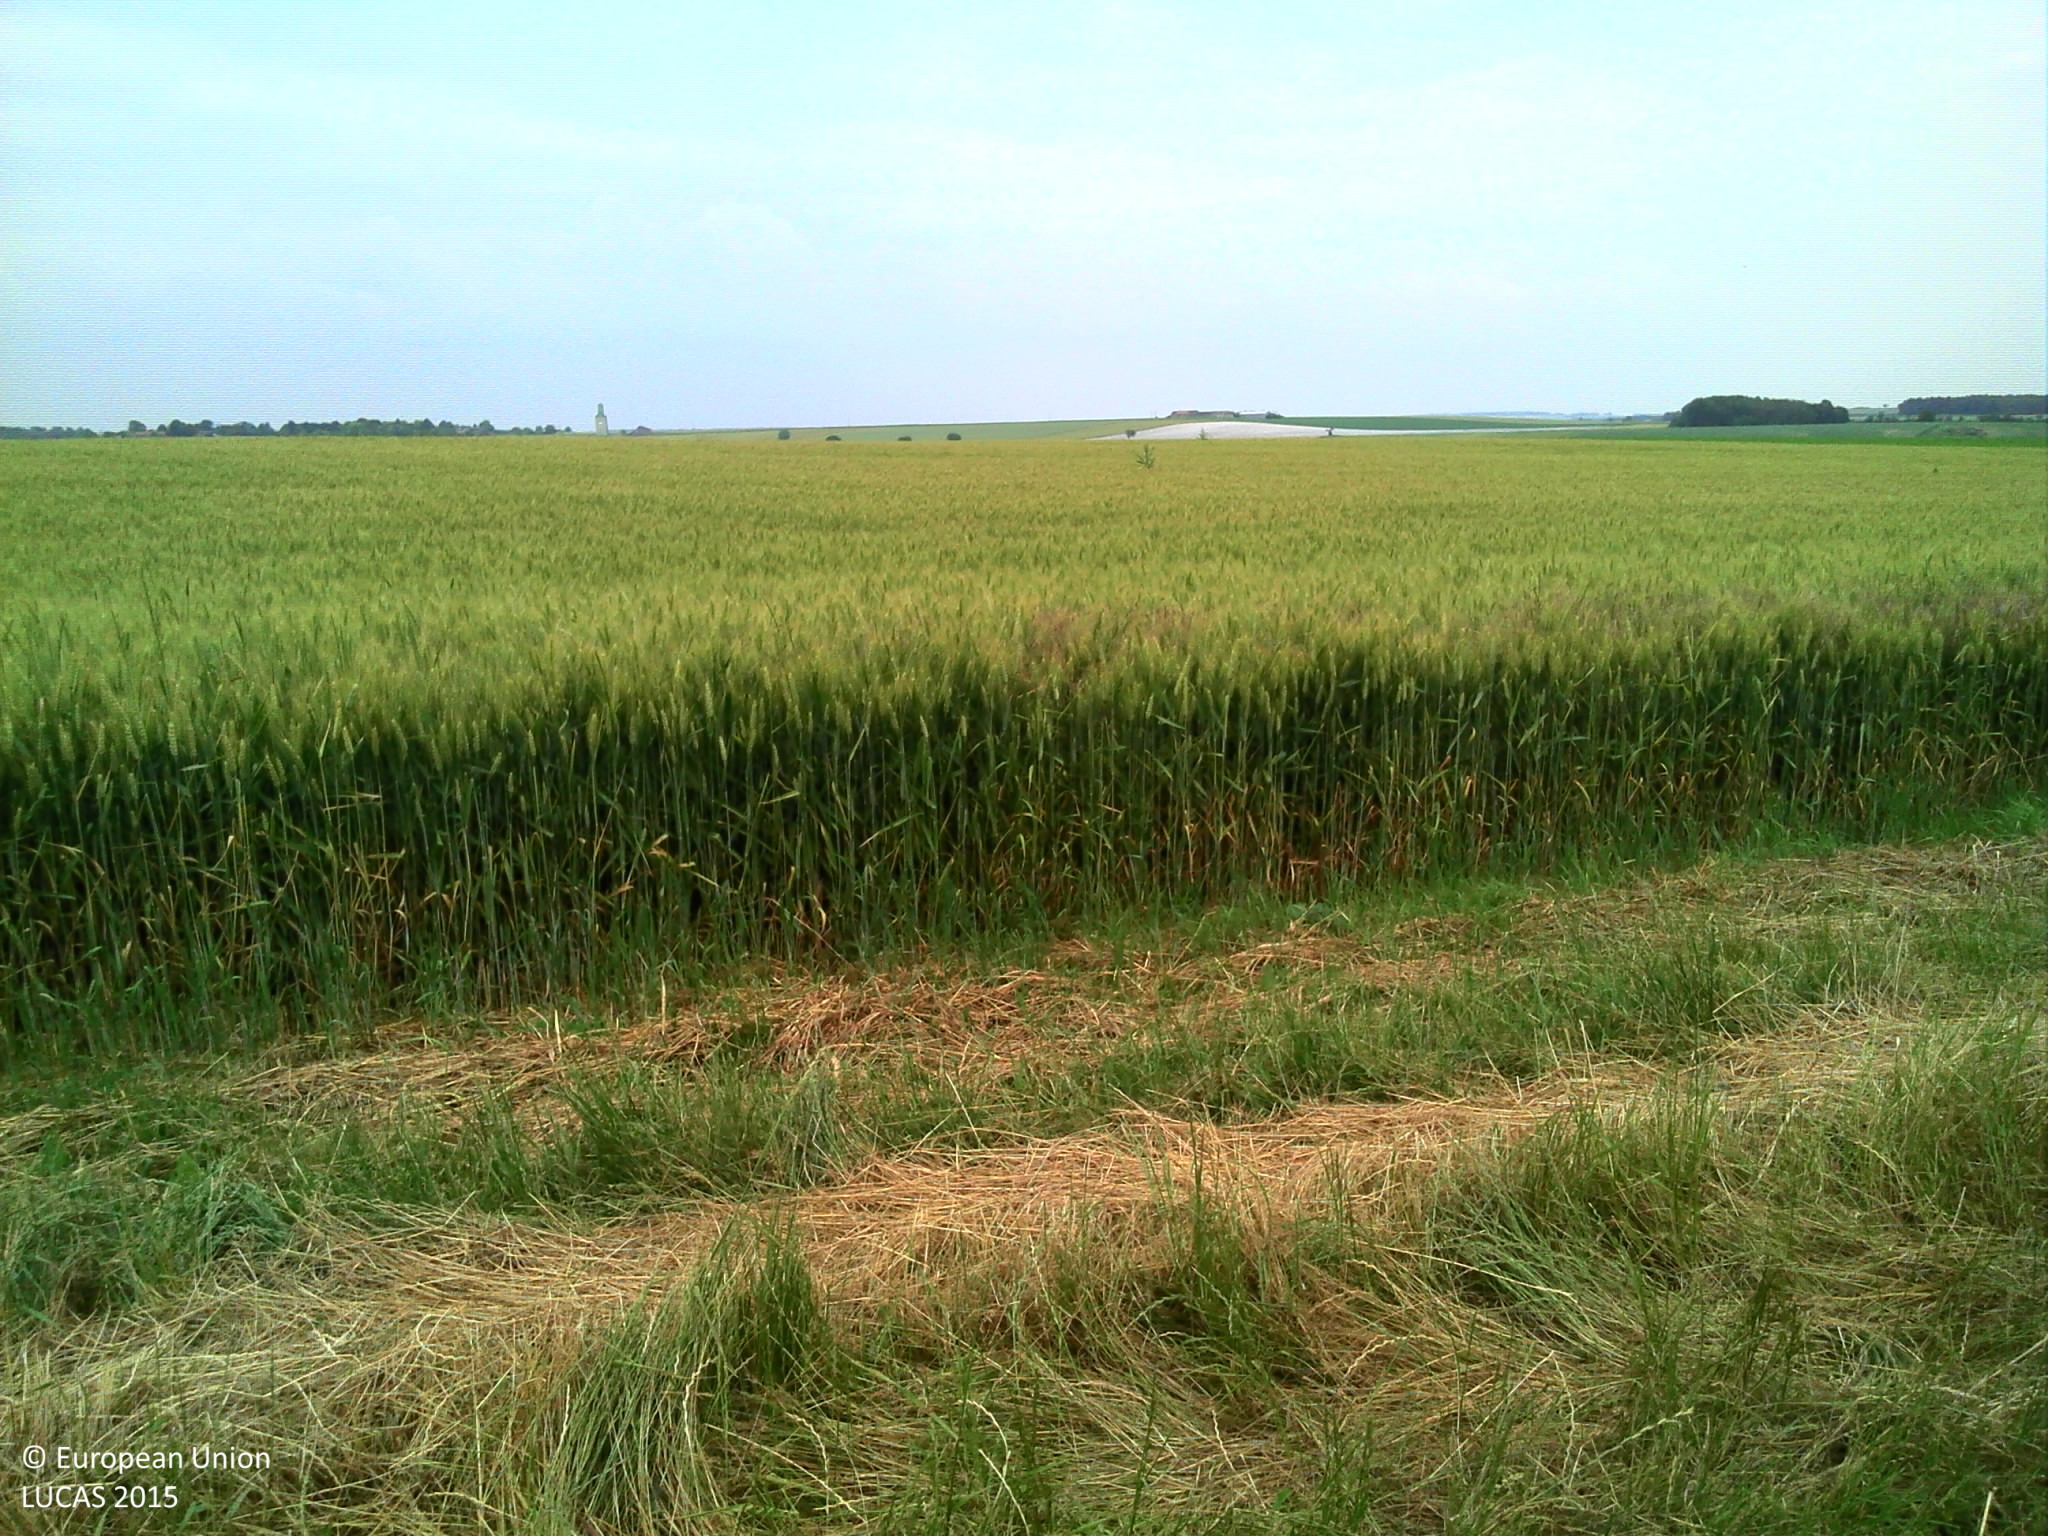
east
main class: Cropland
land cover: Common wheat
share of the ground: > 75 %
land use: Agriculture (excluding fallow land and kitchen gardens)
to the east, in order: Common wheat; Grass margins; Tracks; Grass margins; Common wheat; Maize
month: June
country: FR
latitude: 46.8643
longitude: 0.2321
